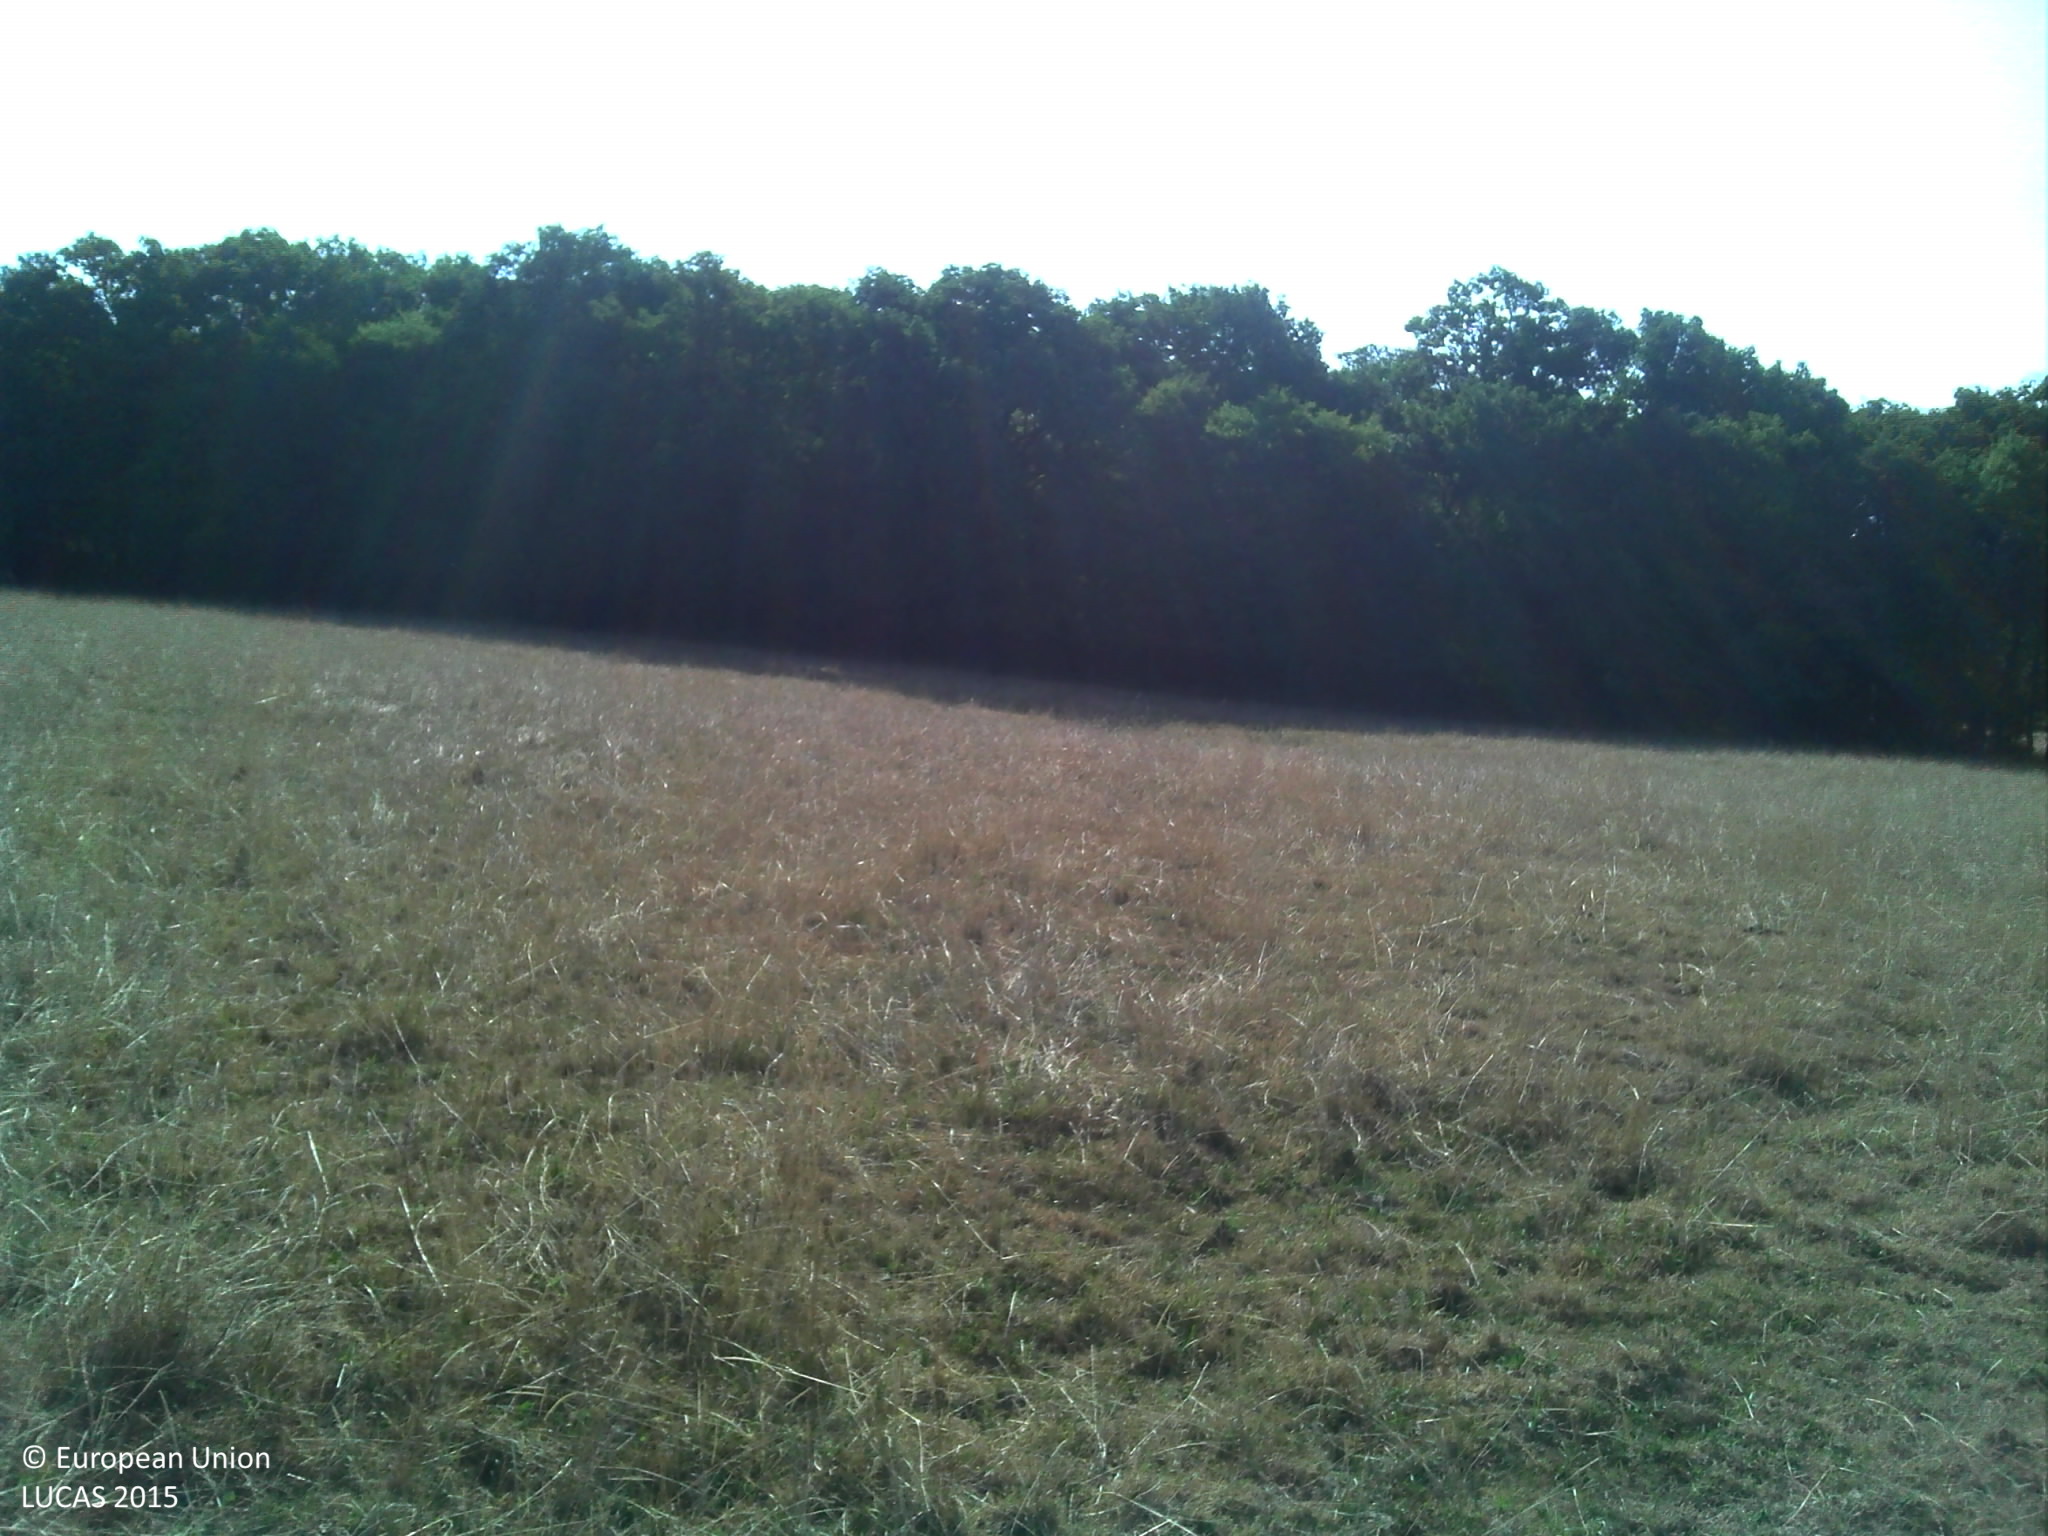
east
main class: Grassland
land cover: Grassland without tree/shrub cover
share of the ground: > 75 %
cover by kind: herbaceous plants 100 %
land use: Agriculture (excluding fallow land and kitchen gardens)
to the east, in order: Grassland without tree/shrub cover; Fences; Ditches and canals; Fences; Broadleaved woodland
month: July
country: FR
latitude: 46.8944
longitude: 3.2110
